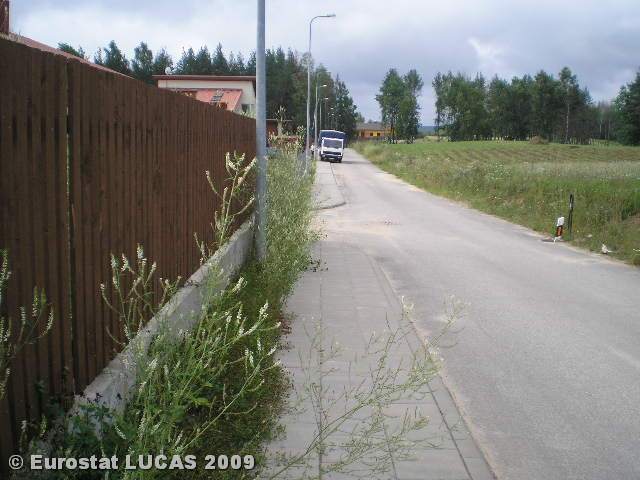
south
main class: Grassland
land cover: Spontaneously vegetated surfaces
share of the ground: > 75 %
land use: Residential
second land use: Construction
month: July
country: LT
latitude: 54.8263
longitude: 25.2660
